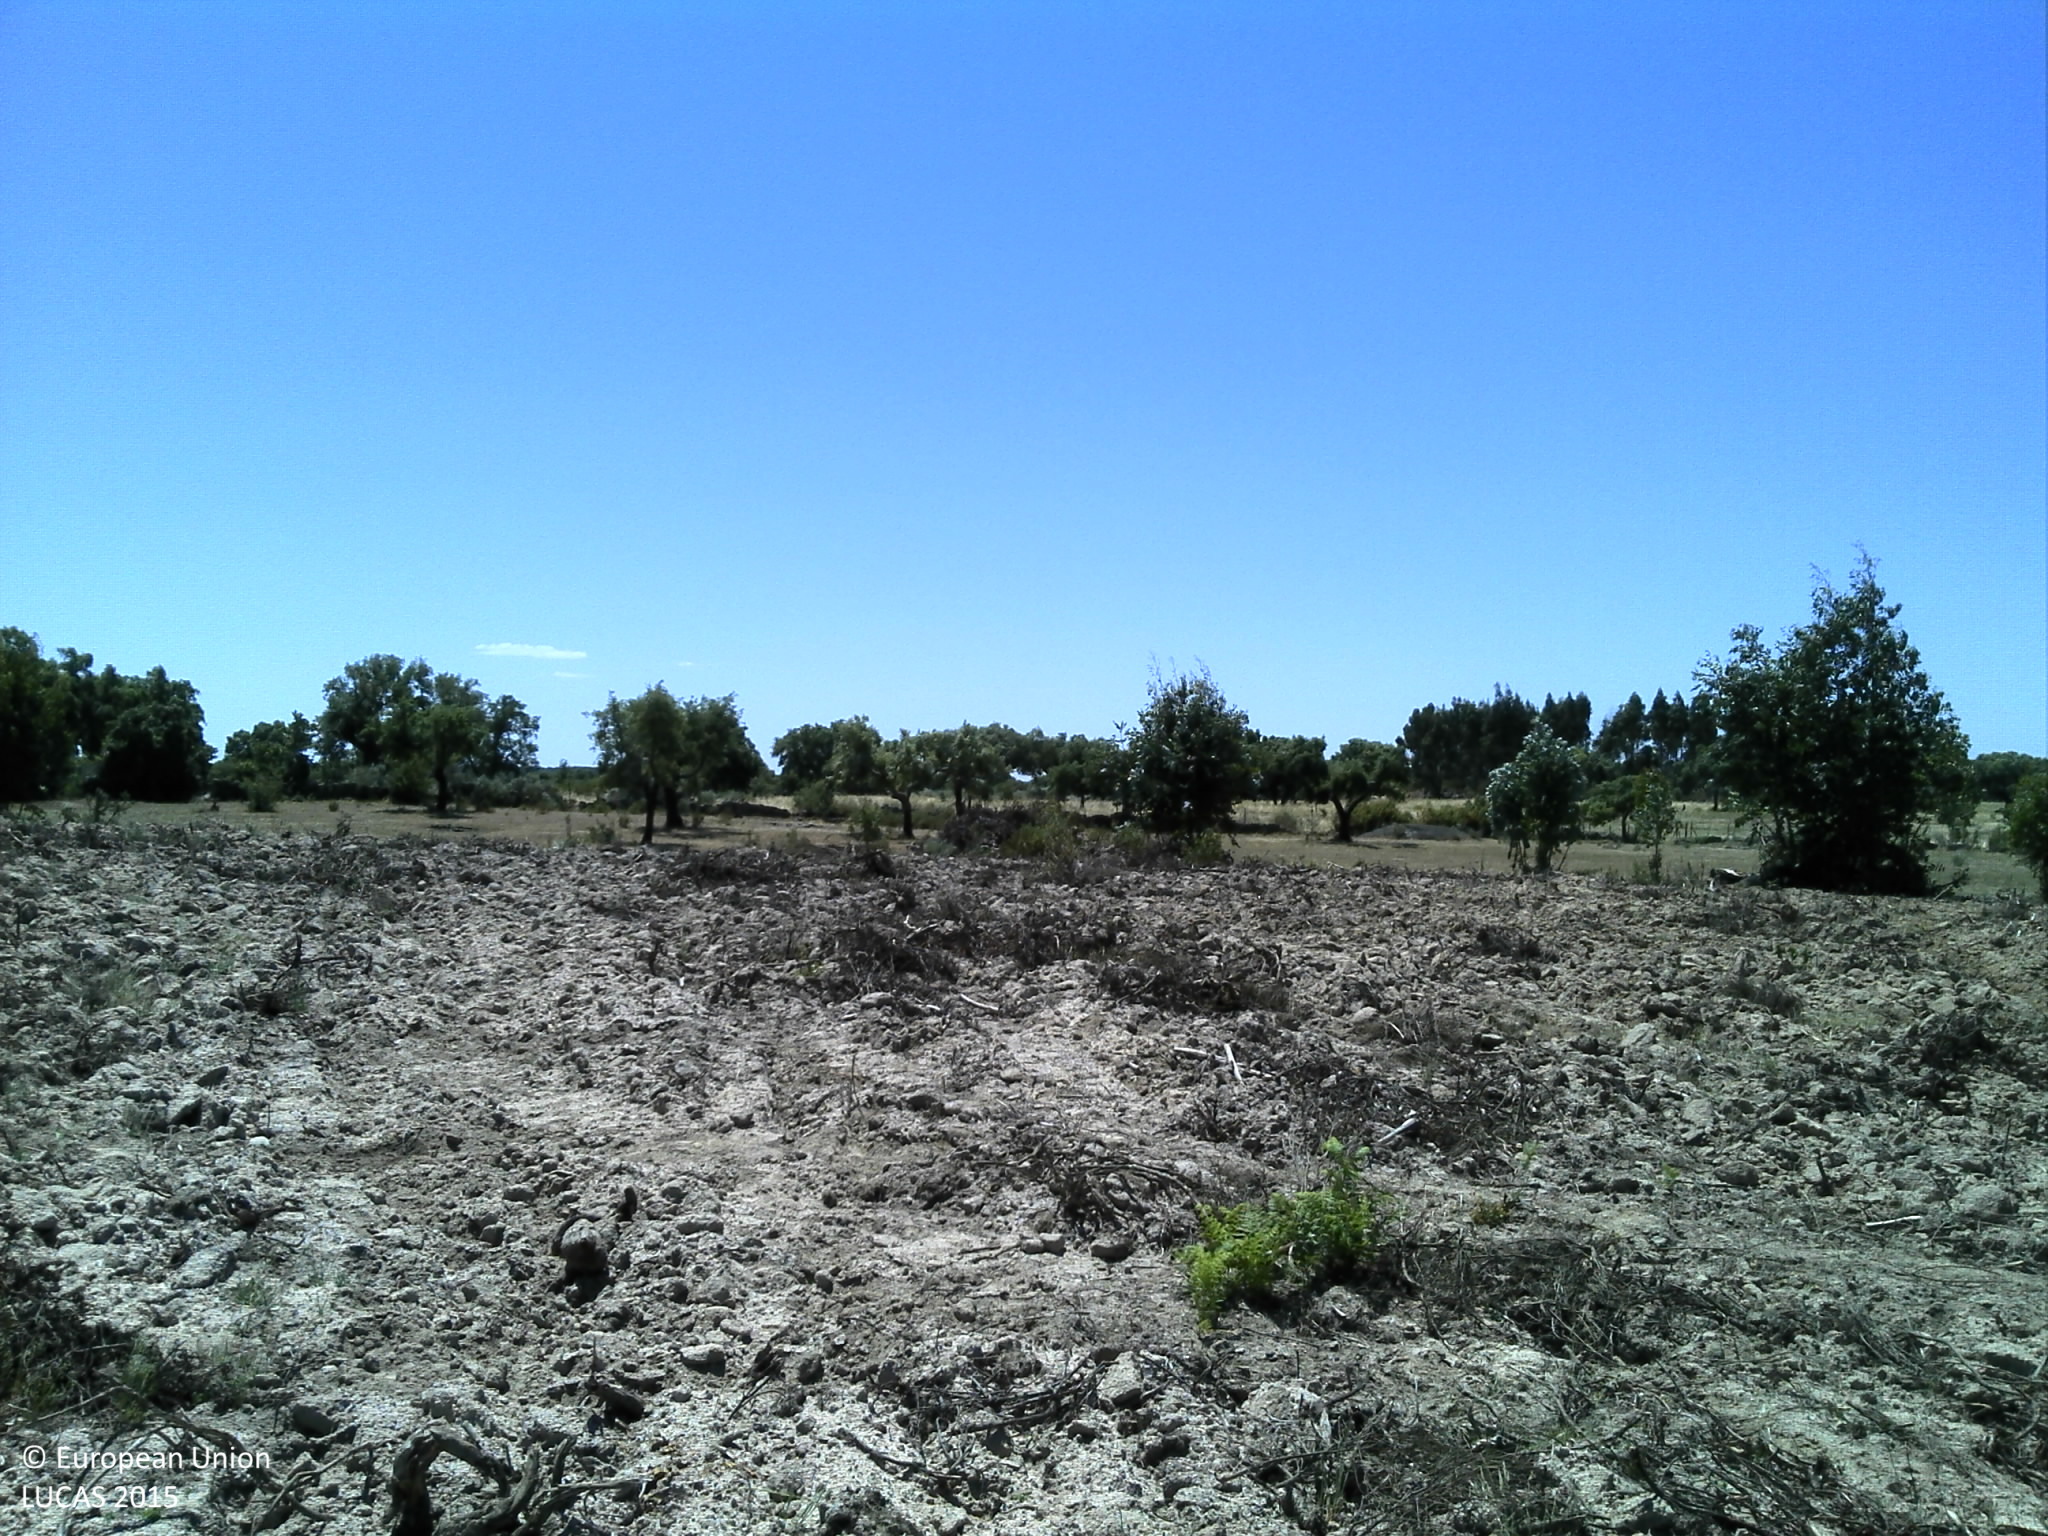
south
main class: Woodland
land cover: Broadleaved woodland
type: exotic forest
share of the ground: 10 - 25 %
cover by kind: unconsolidated bare surface 90 %, broadleaved forest trees 10 %
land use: Forestry
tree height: > 5 m
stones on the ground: < 10 %
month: May
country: PT
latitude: 39.4554
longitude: -7.7041
